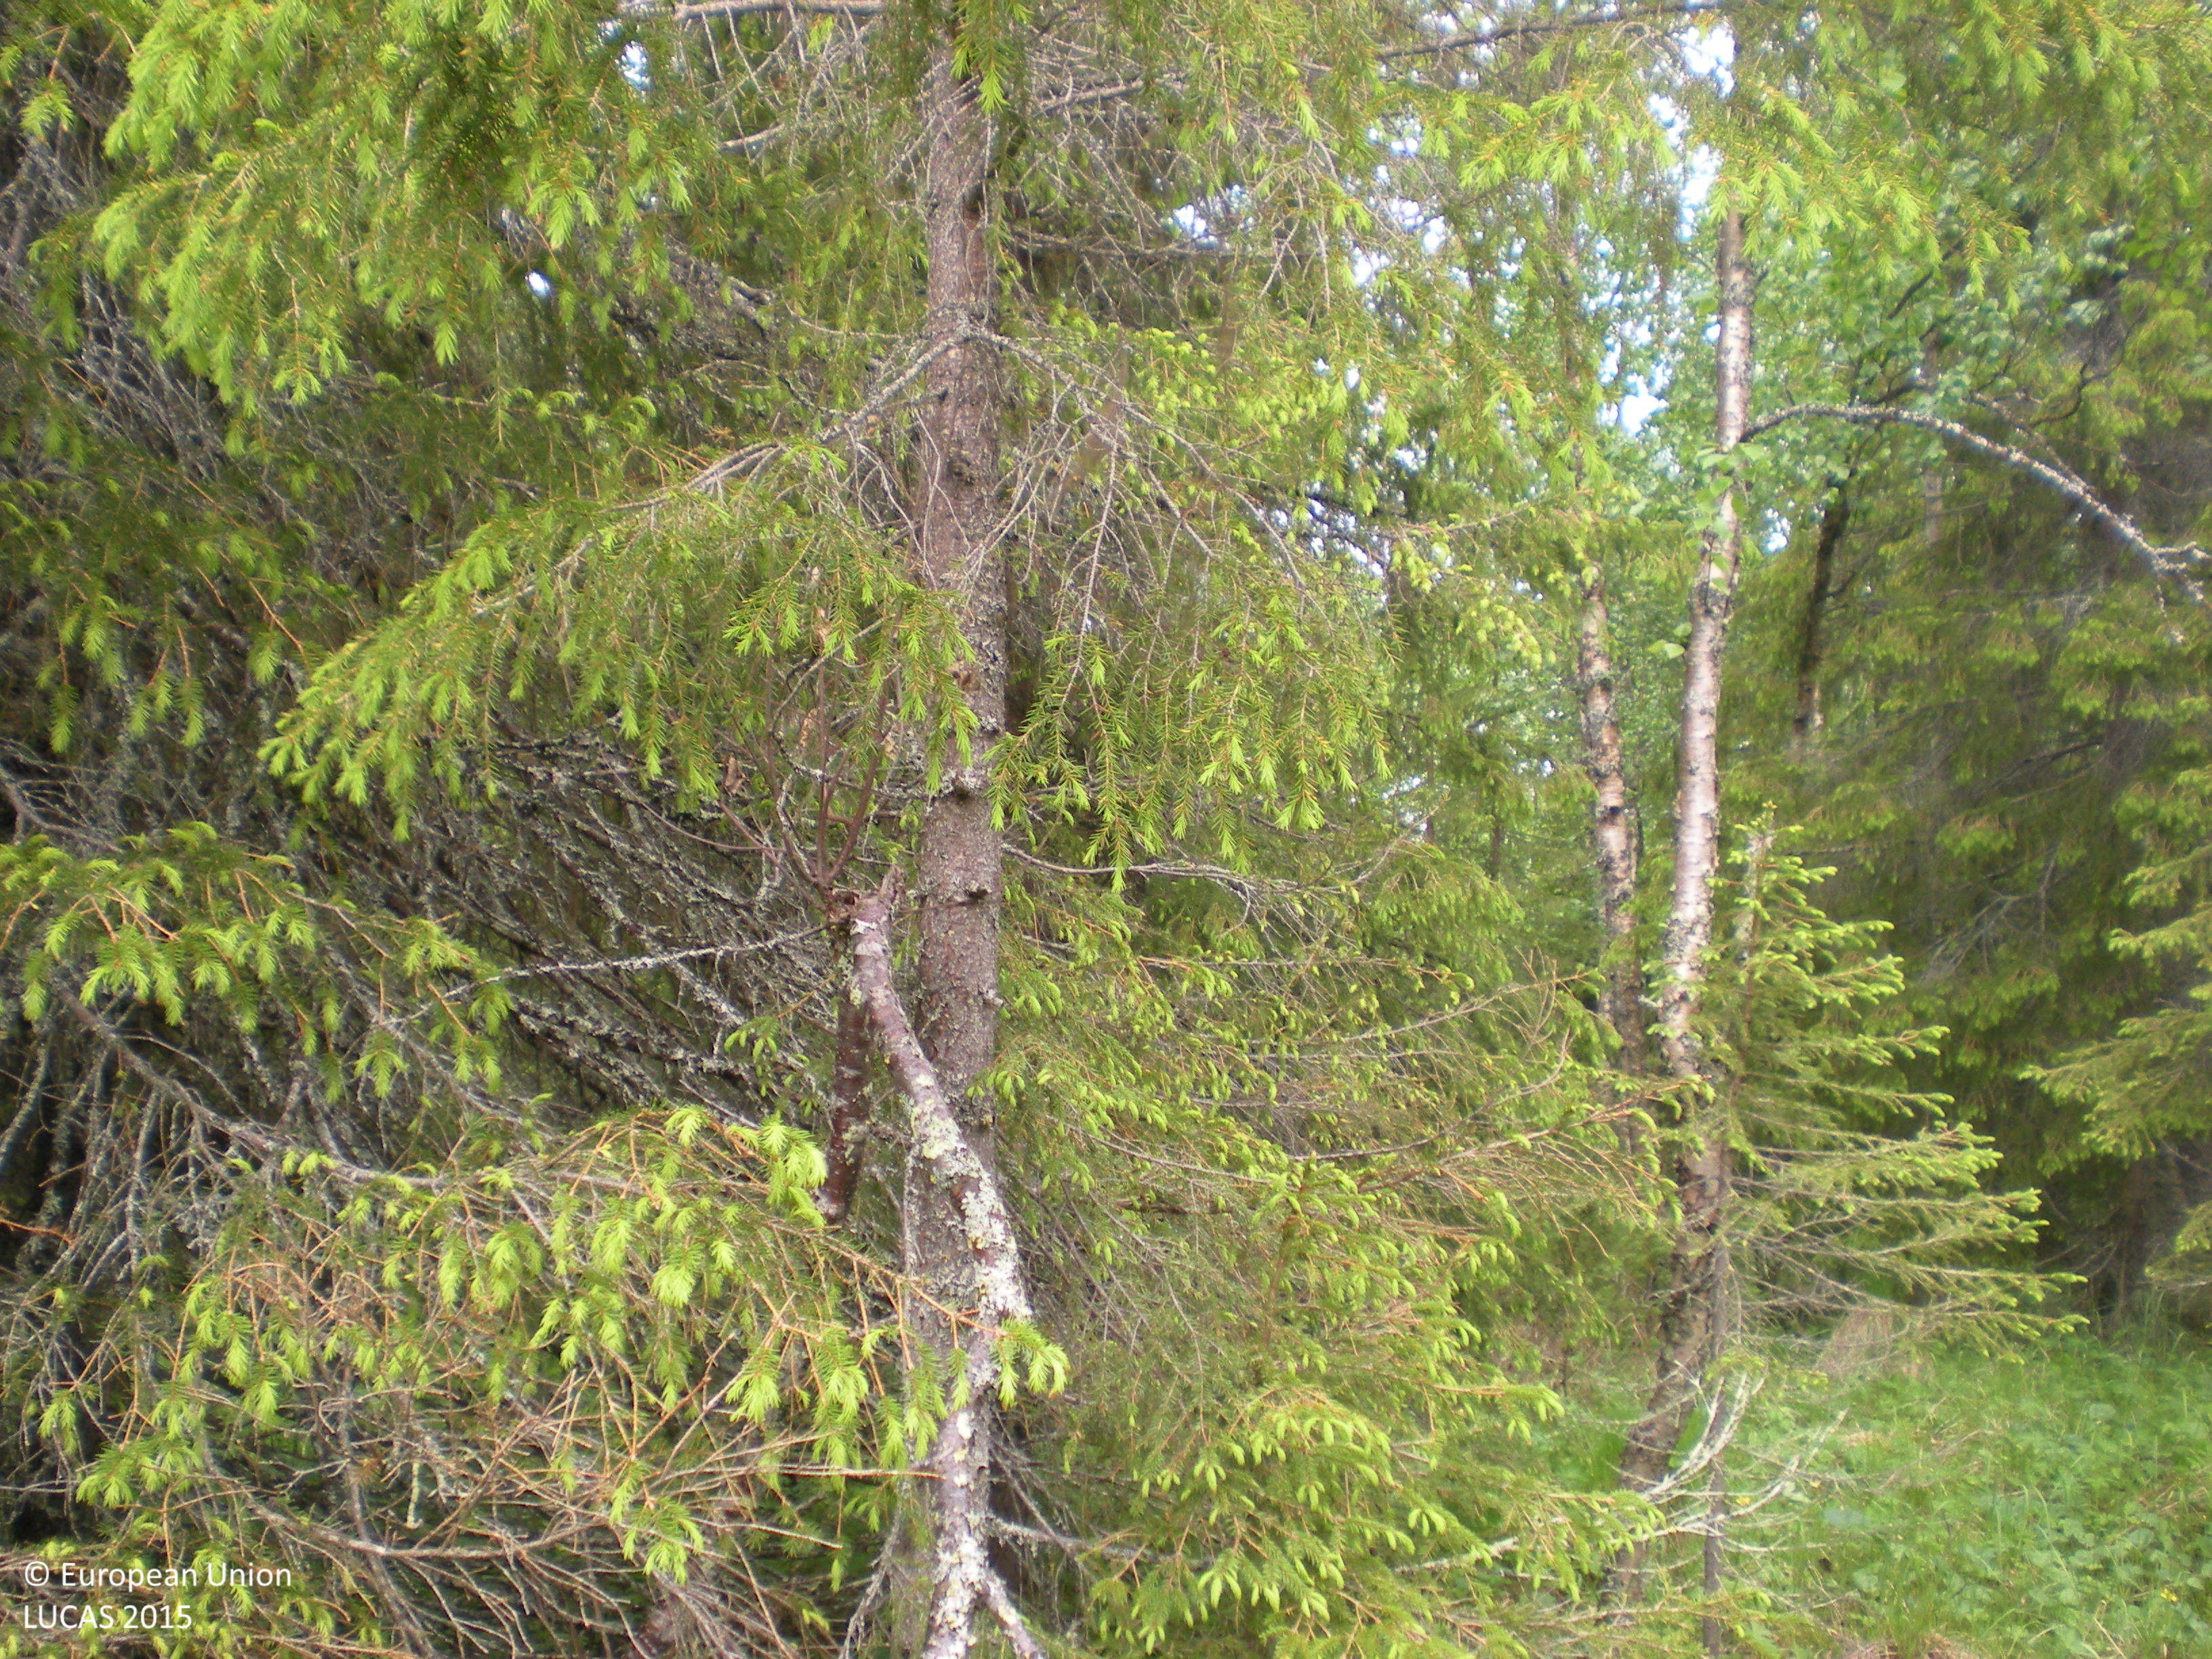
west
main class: Woodland
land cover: Spruce dominated mixed woodland
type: boreal forest
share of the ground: 50 - 75 %
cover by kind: coniferous forest trees 50 %, broadleaved forest trees 20 %, shrubs 15 %, herbaceous plants 10 %, lichens and mosses 5 %
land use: Forestry
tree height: > 5 m
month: July
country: SE
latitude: 66.0874
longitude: 17.1854
